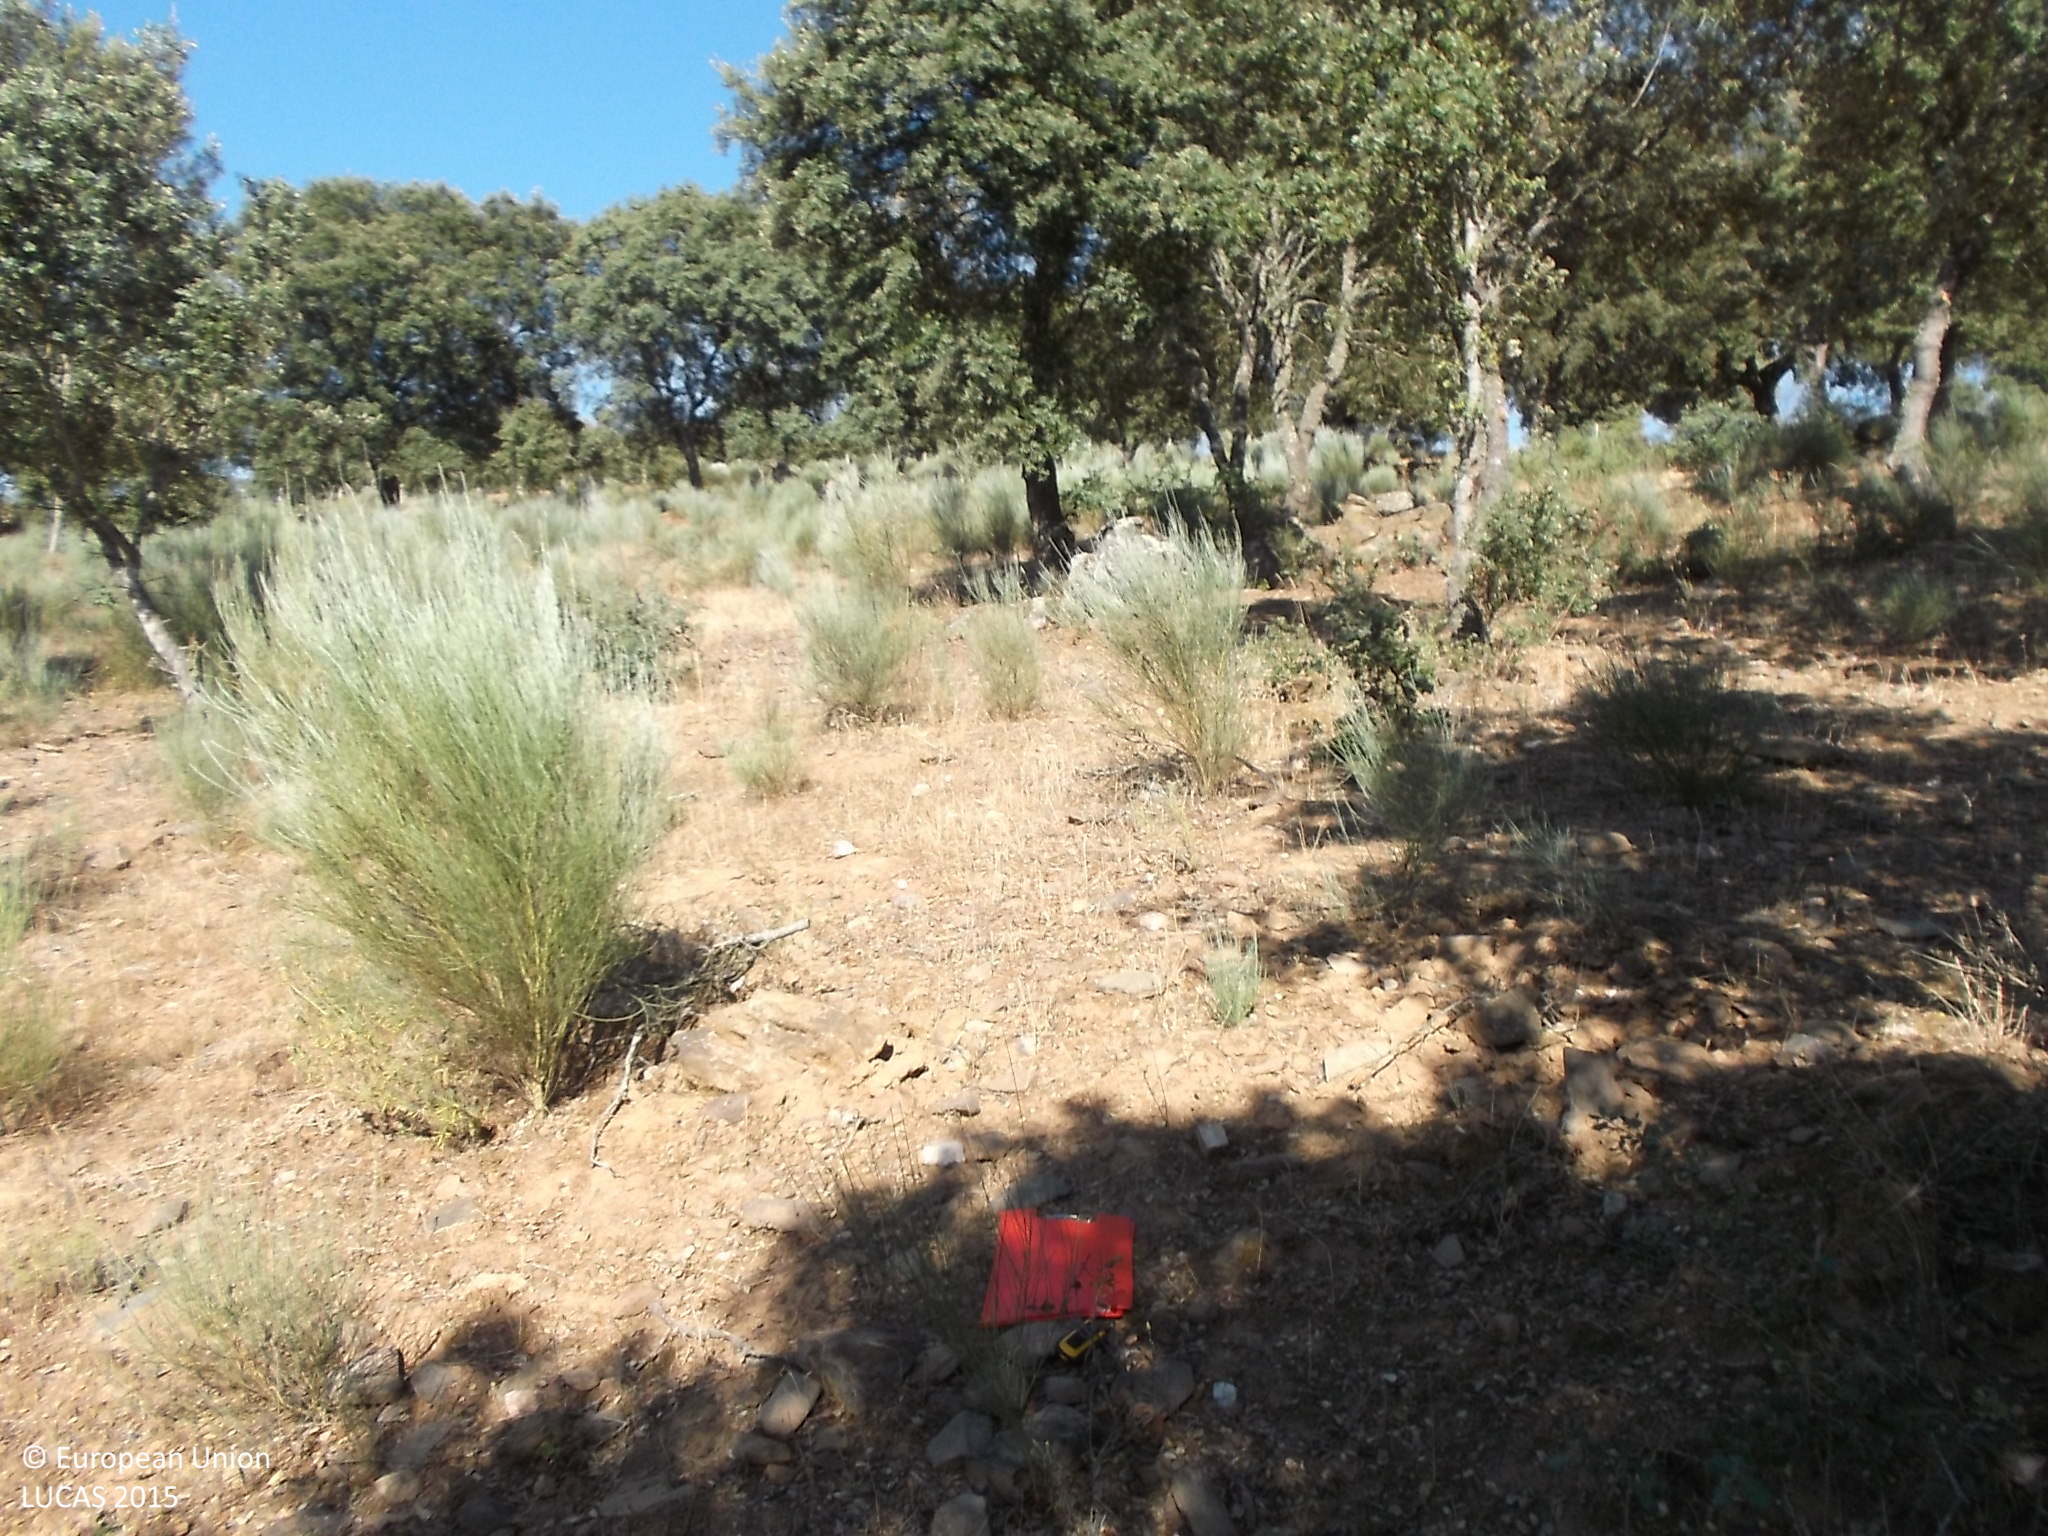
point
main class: Woodland
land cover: Broadleaved woodland
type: broadleaved evergreen forest
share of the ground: 25 - 50 %
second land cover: Shrubland without tree cover
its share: 25 - 50 %
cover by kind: herbaceous plants 40 %, broadleaved forest trees 30 %, shrubs 30 %
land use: Forestry
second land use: Agriculture (excluding fallow land and kitchen gardens)
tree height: < 5 m
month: July
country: ES
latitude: 40.8324
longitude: -6.8083
